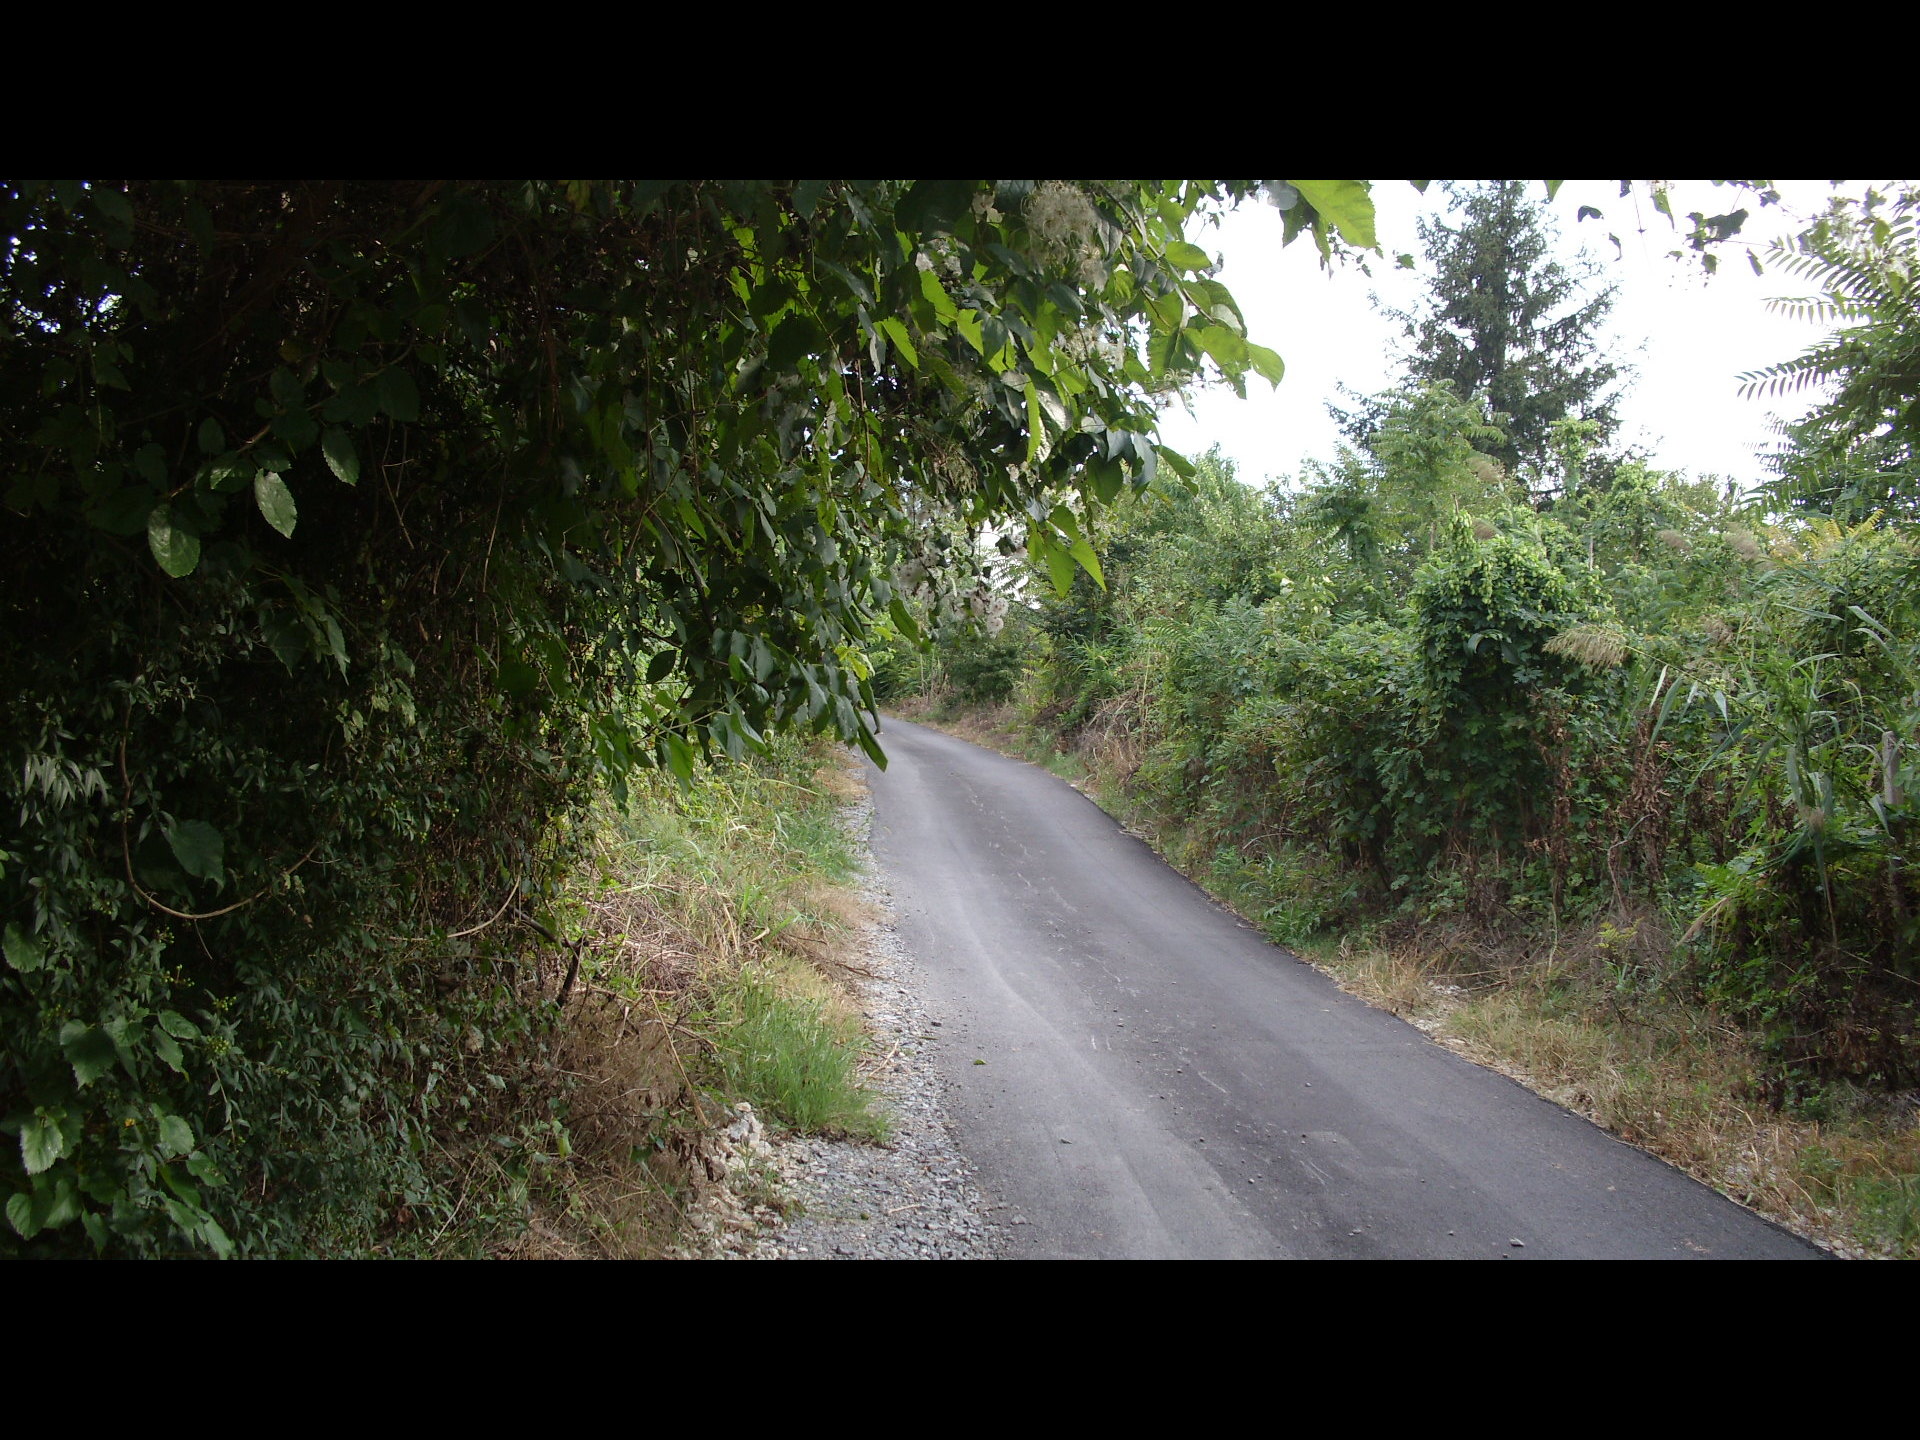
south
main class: Woodland
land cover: Broadleaved woodland
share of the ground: > 75 %
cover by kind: broadleaved forest trees 100 %
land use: Abandoned areas
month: September
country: BG
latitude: 43.8383
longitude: 23.2900
